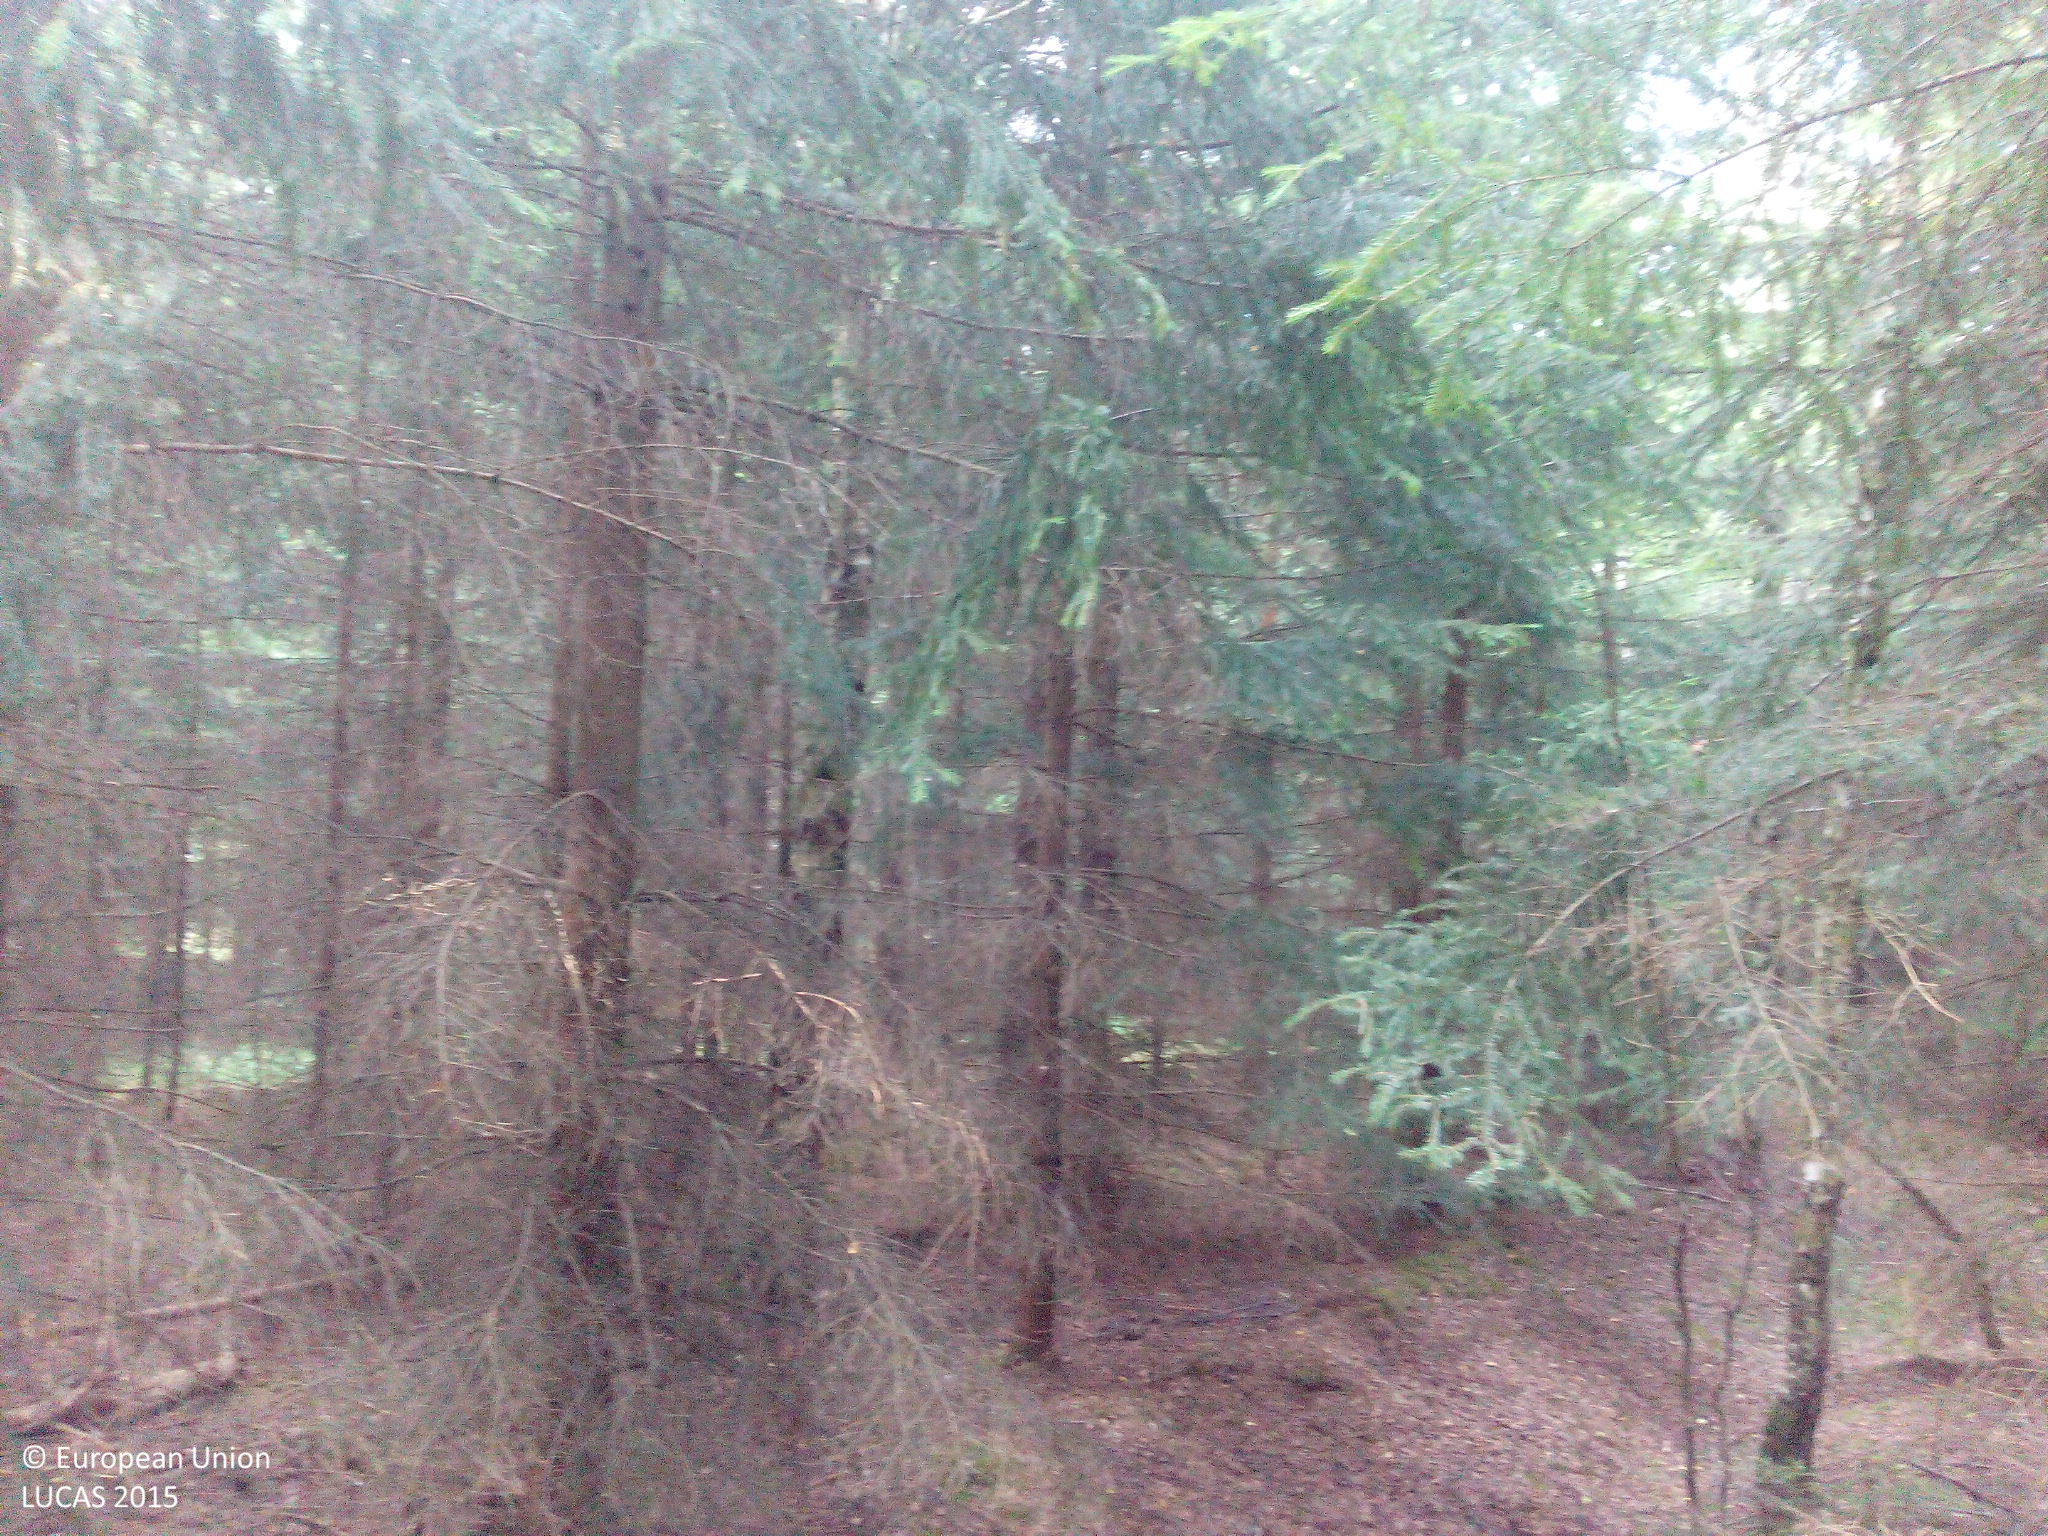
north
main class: Woodland
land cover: Spruce dominated coniferous woodland
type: hemiboreal forest and nemoral coniferous forest and mixed broadleaved-coniferous forest
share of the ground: > 75 %
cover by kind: coniferous forest trees 90 %, herbaceous plants 10 %
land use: Forestry
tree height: > 5 m
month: July
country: DE
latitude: 50.9400
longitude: 13.5156
